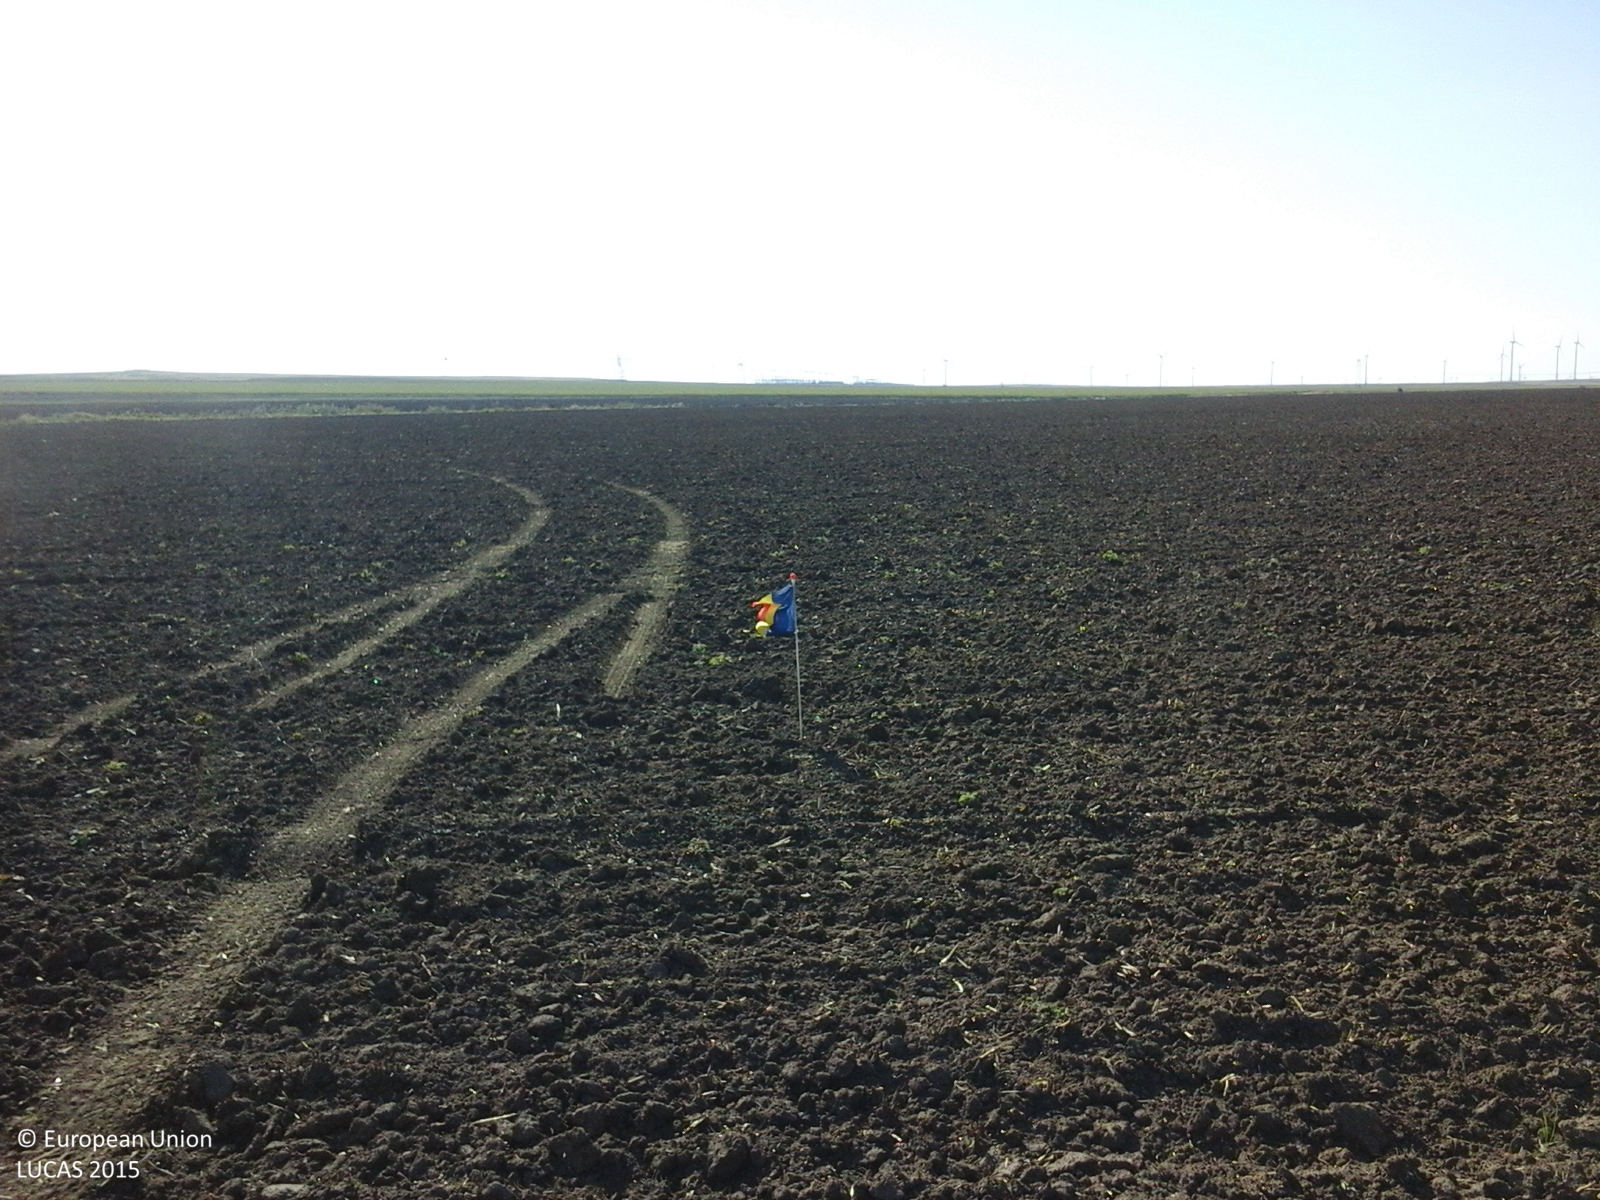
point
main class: Cropland
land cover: Common wheat
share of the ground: < 10 %
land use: Agriculture (excluding fallow land and kitchen gardens)
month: August
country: RO
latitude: 44.5799
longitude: 28.6555
